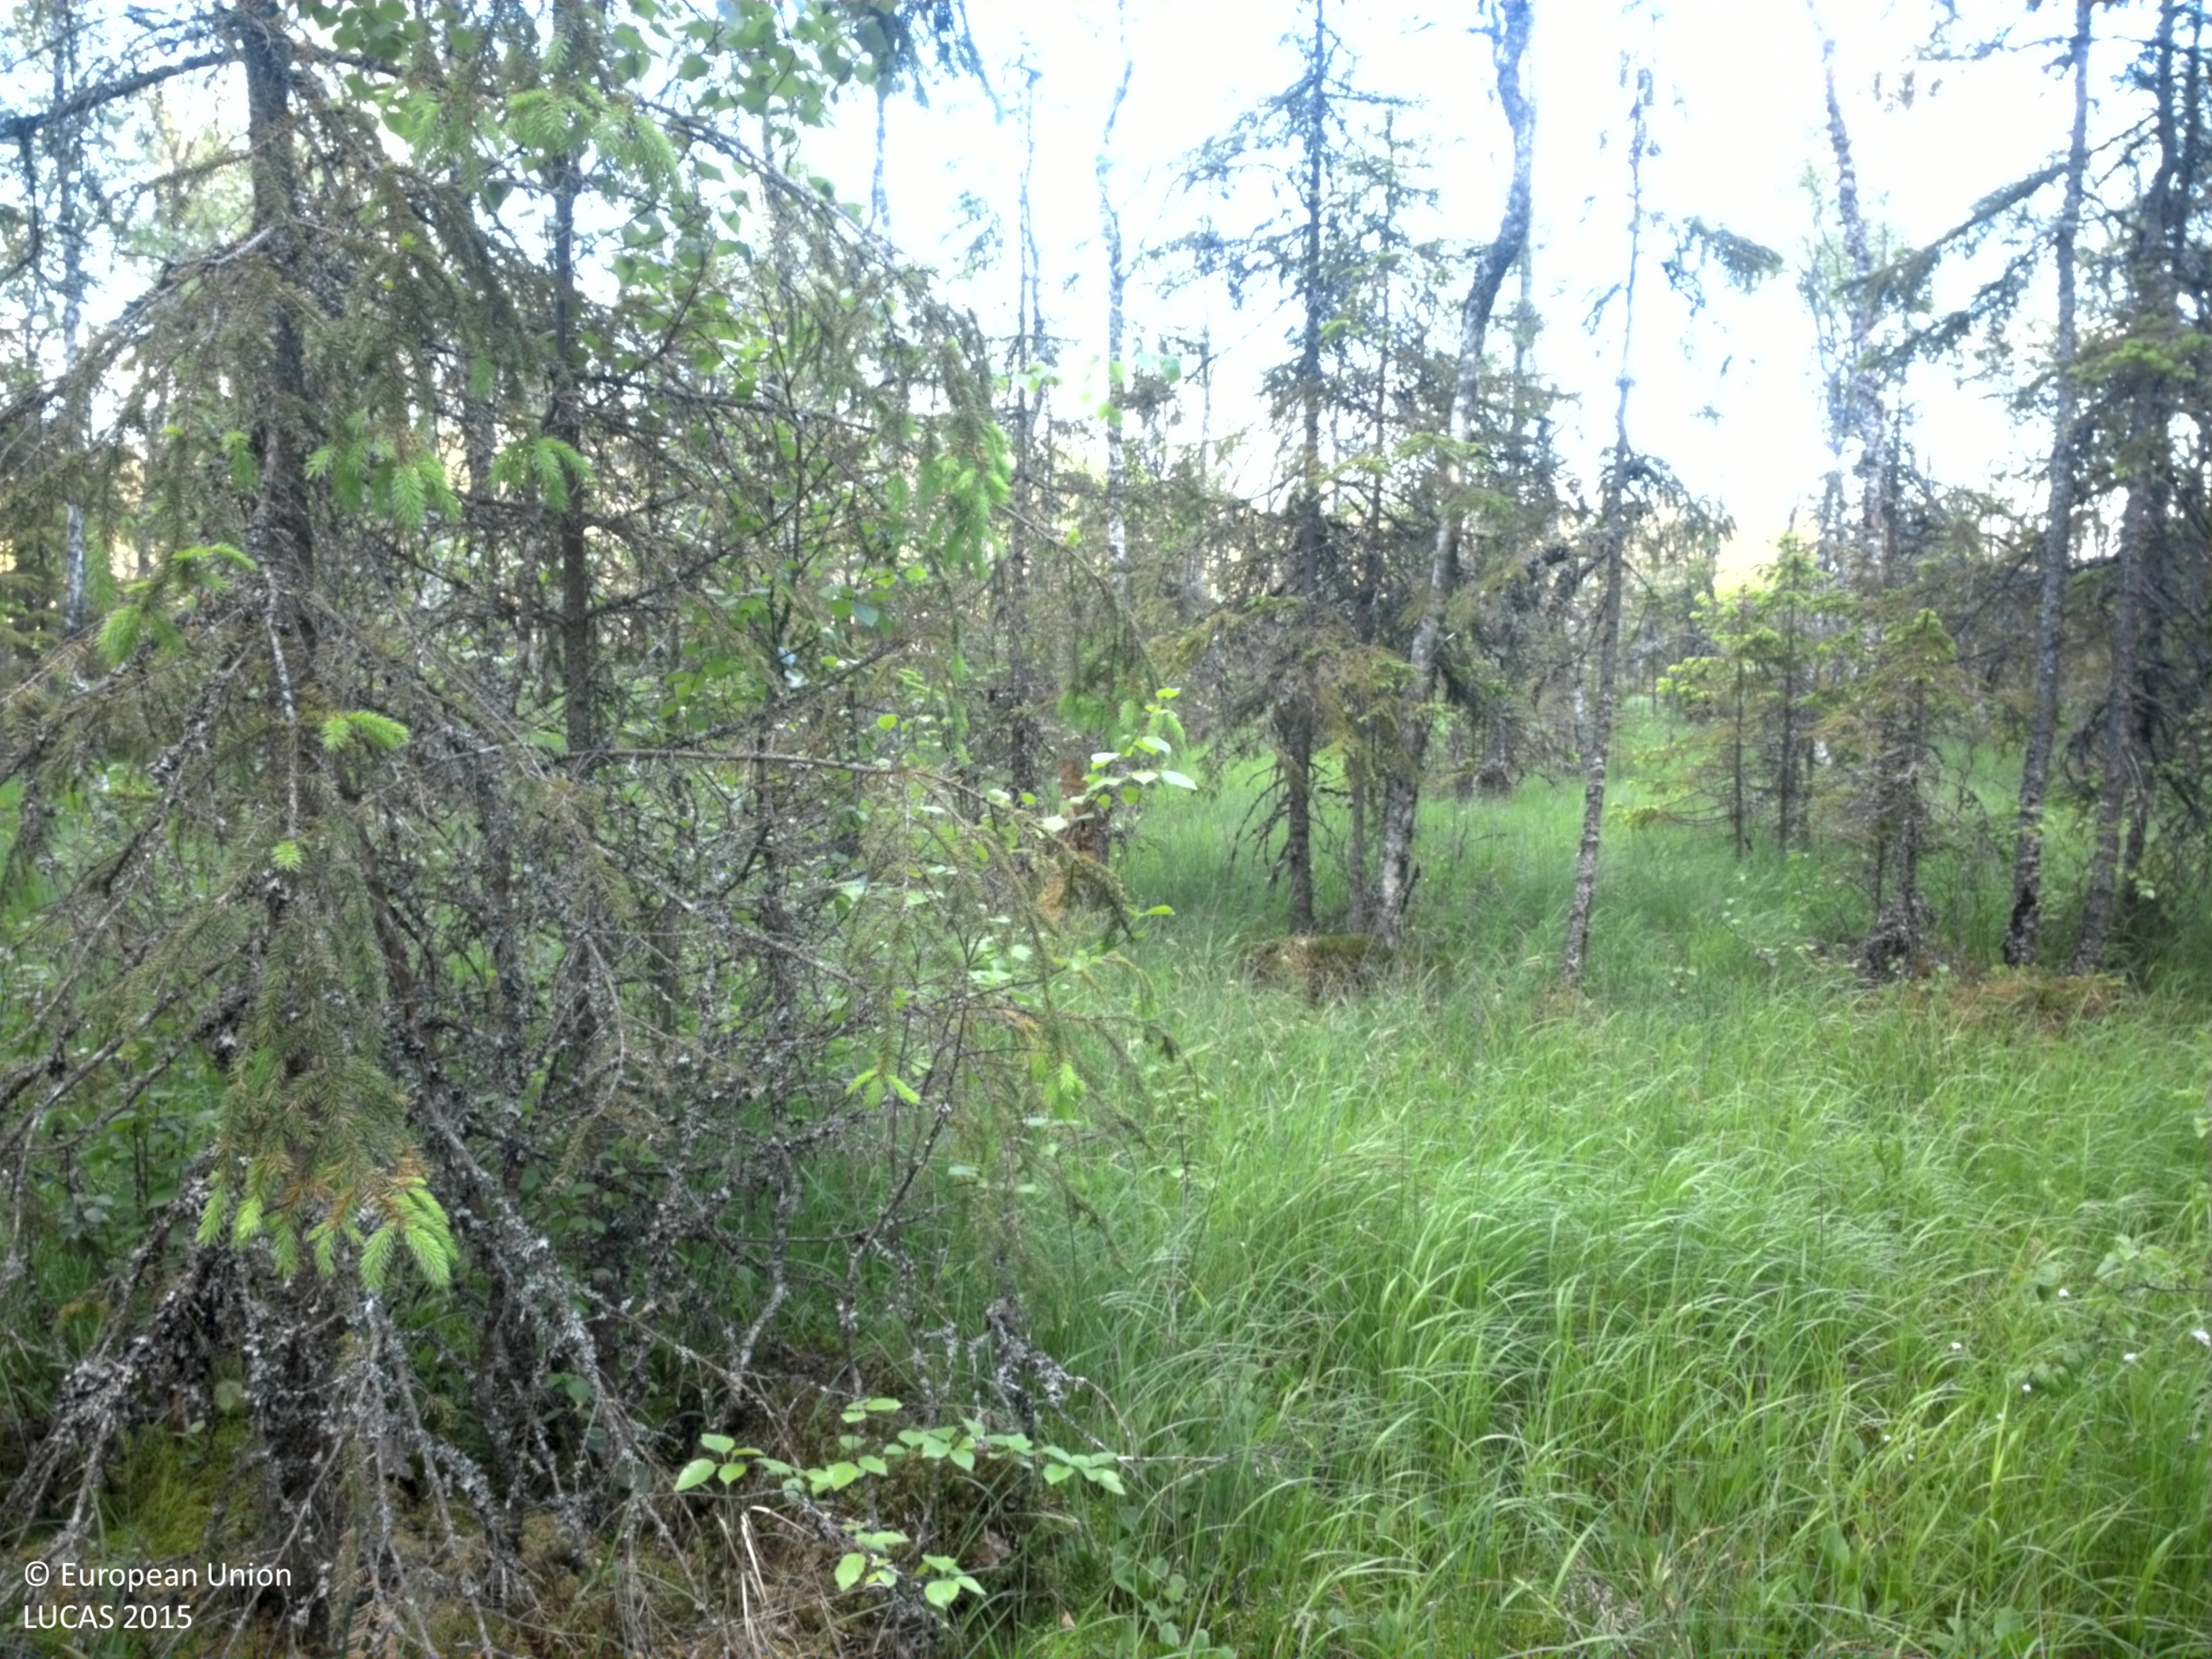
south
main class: Woodland
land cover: Spruce dominated mixed woodland
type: mire and swamp forests
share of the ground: 50 - 75 %
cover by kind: herbaceous plants 35 %, broadleaved forest trees 30 %, coniferous forest trees 20 %, lichens and mosses 15 %
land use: Semi-natural and natural areas not in use
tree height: > 5 m
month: June
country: SE
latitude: 59.6158
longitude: 14.1209
